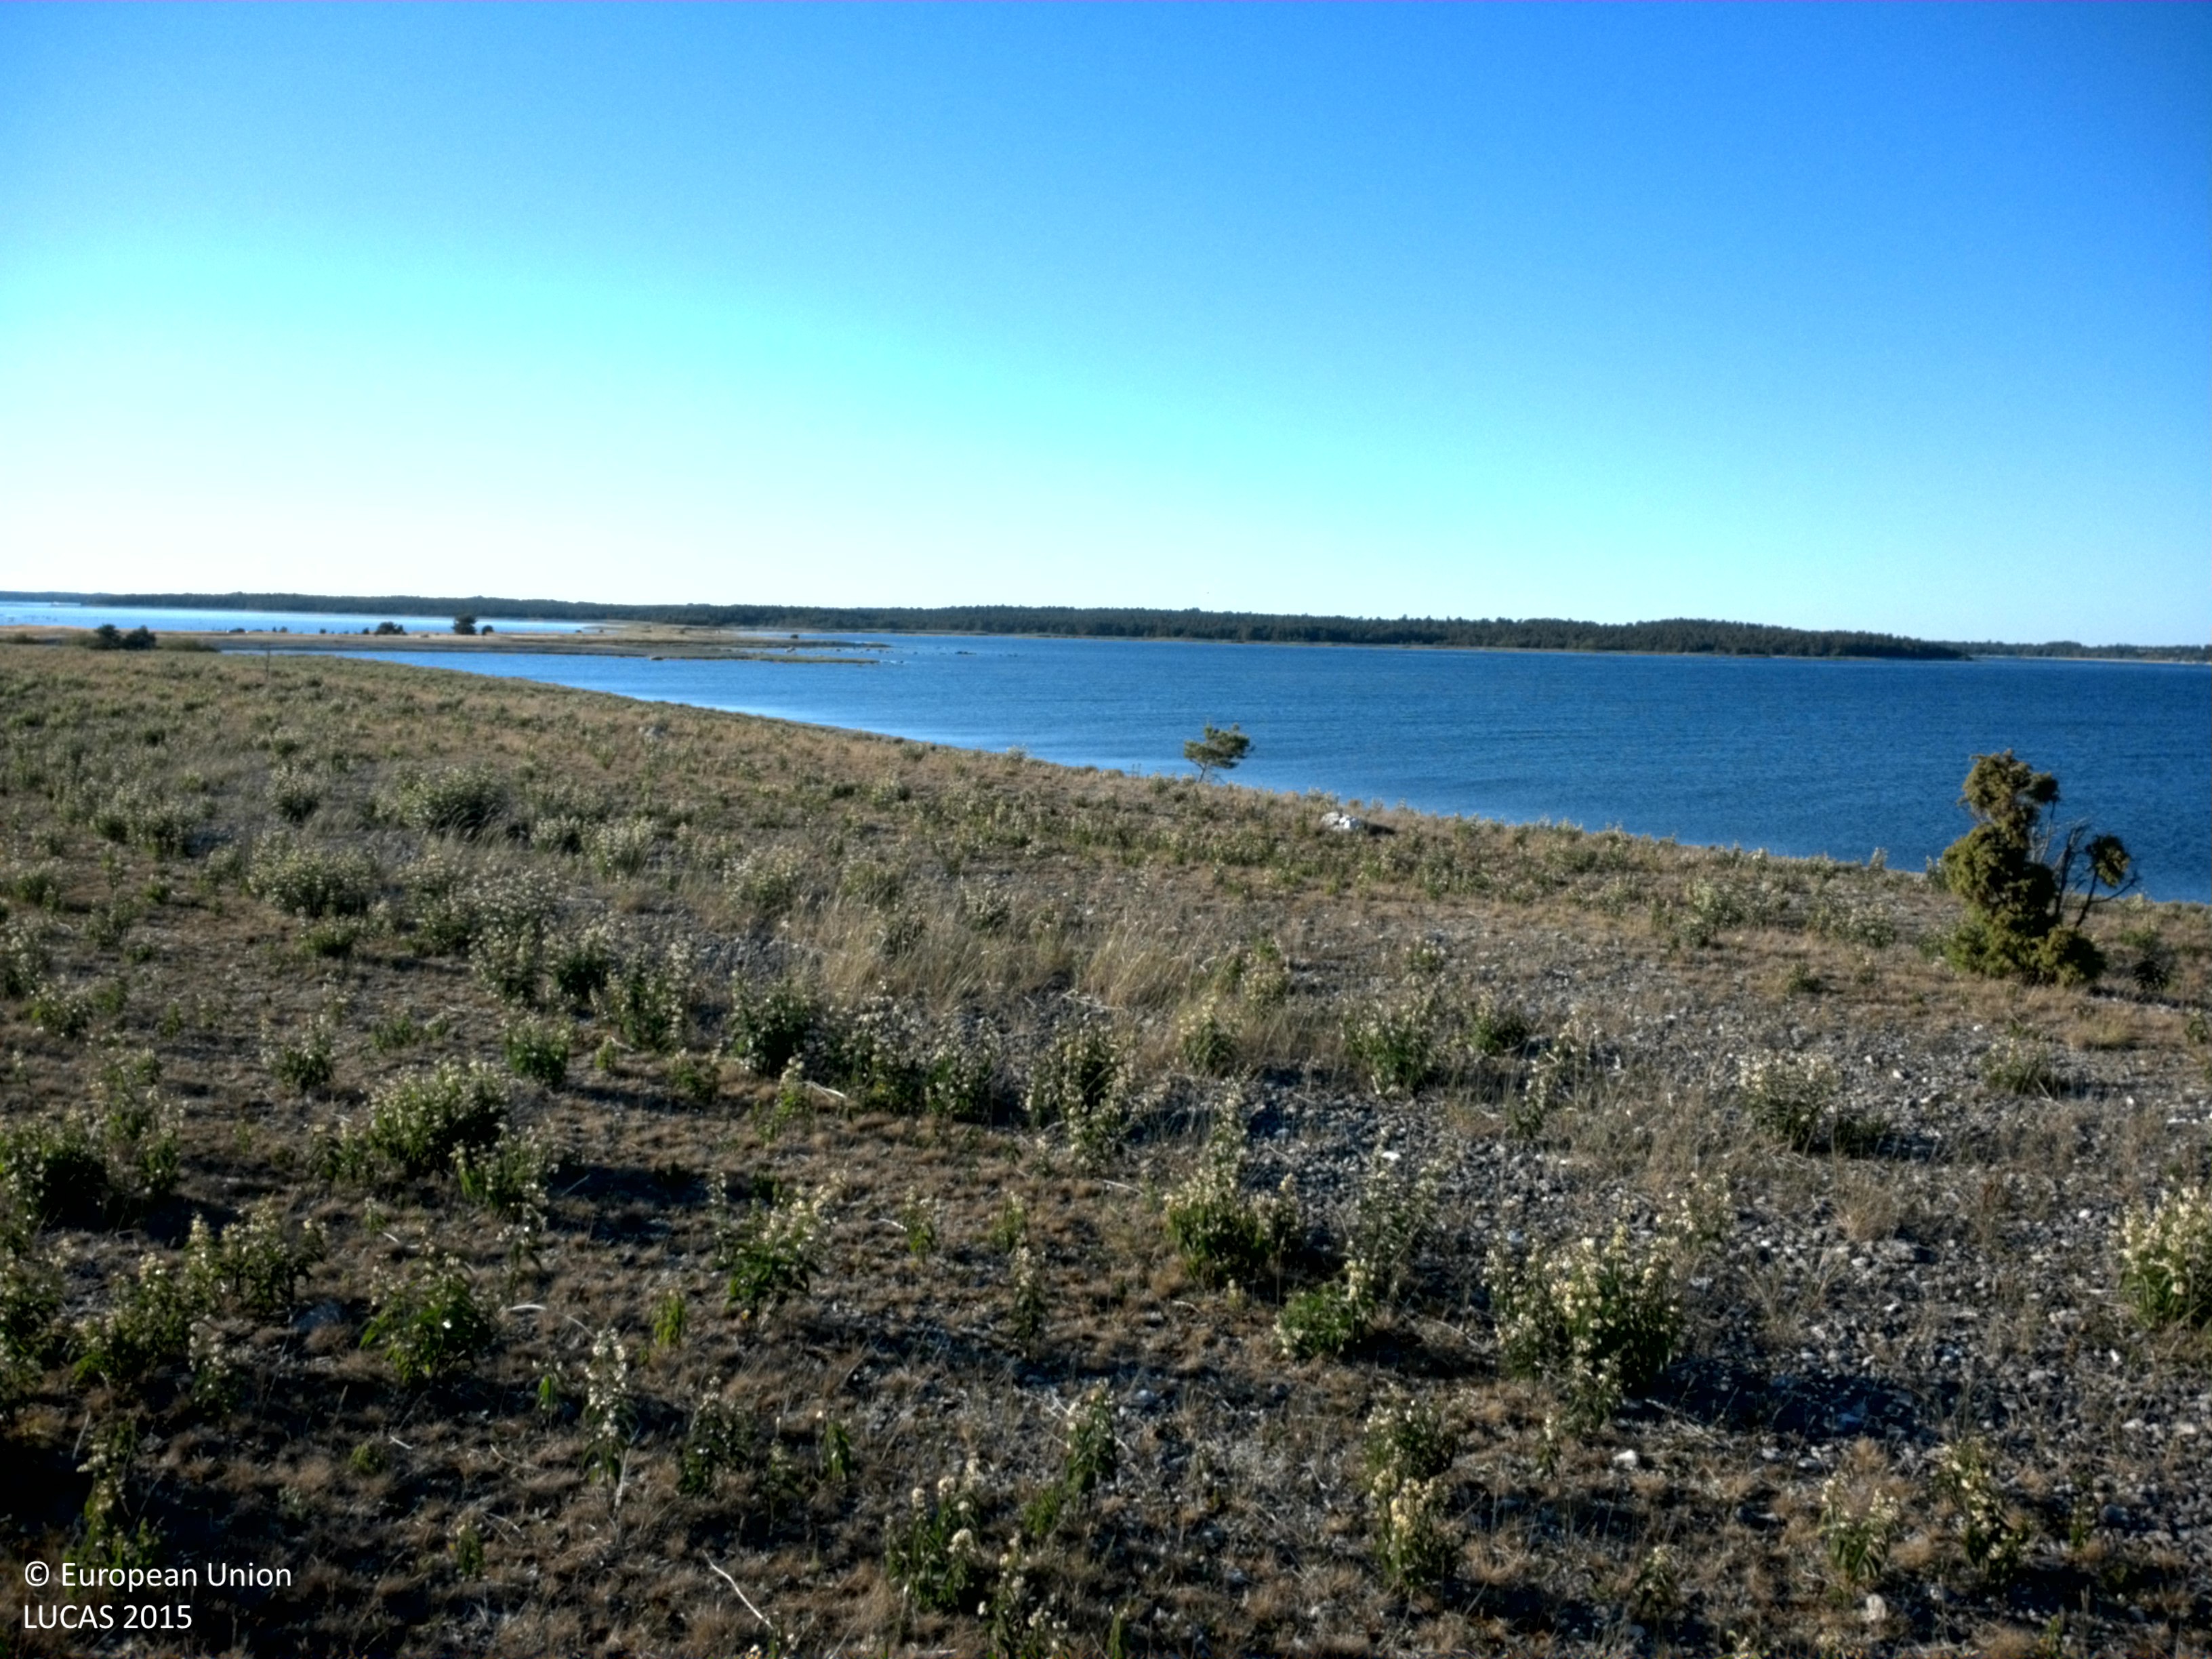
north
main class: Grassland
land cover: Grassland without tree/shrub cover
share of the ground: > 75 %
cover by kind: herbaceous plants 80 %, unconsolidated bare surface 15 %, lichens and mosses 5 %
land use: Agriculture (excluding fallow land and kitchen gardens)
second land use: Amenities, museums, leisure
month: July
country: SE
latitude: 57.7096
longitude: 18.8552
